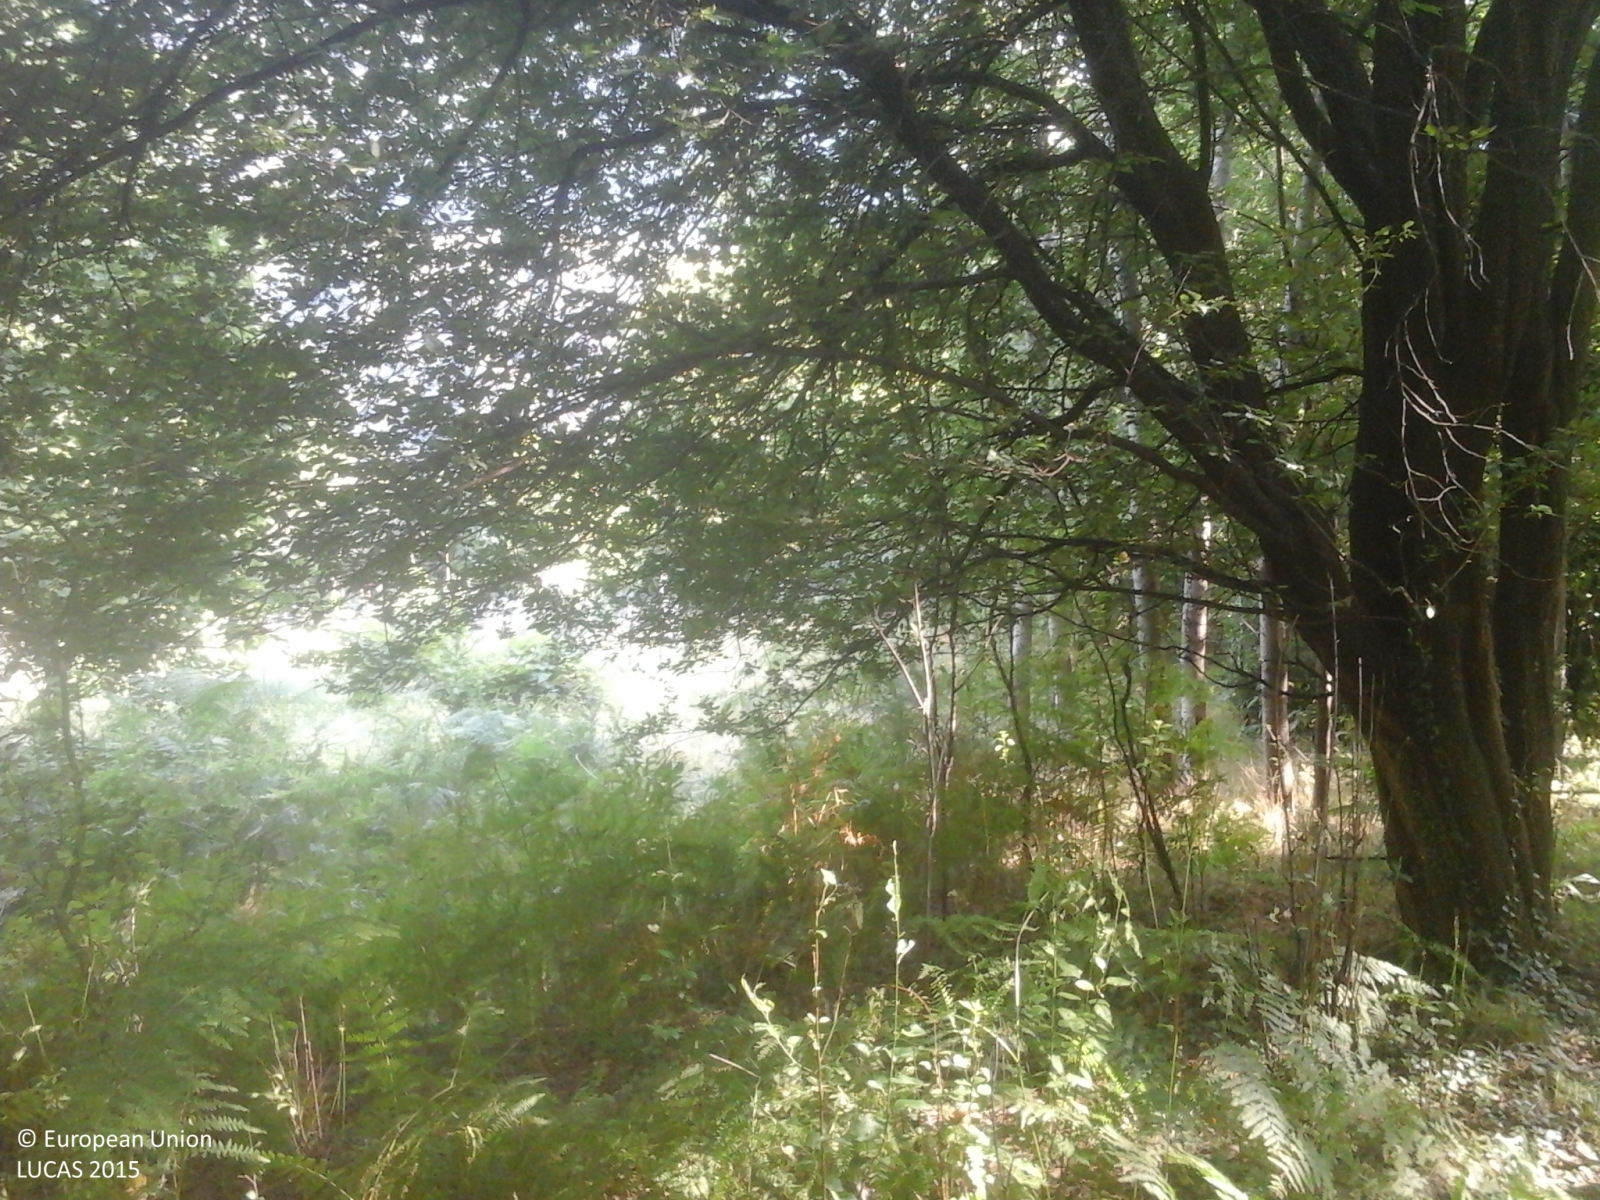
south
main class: Woodland
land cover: Broadleaved woodland
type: thermophilous deciduous forest
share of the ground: > 75 %
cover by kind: broadleaved forest trees 100 %
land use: Forestry
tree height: > 5 m
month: July
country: IT
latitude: 46.3316
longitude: 9.4162
